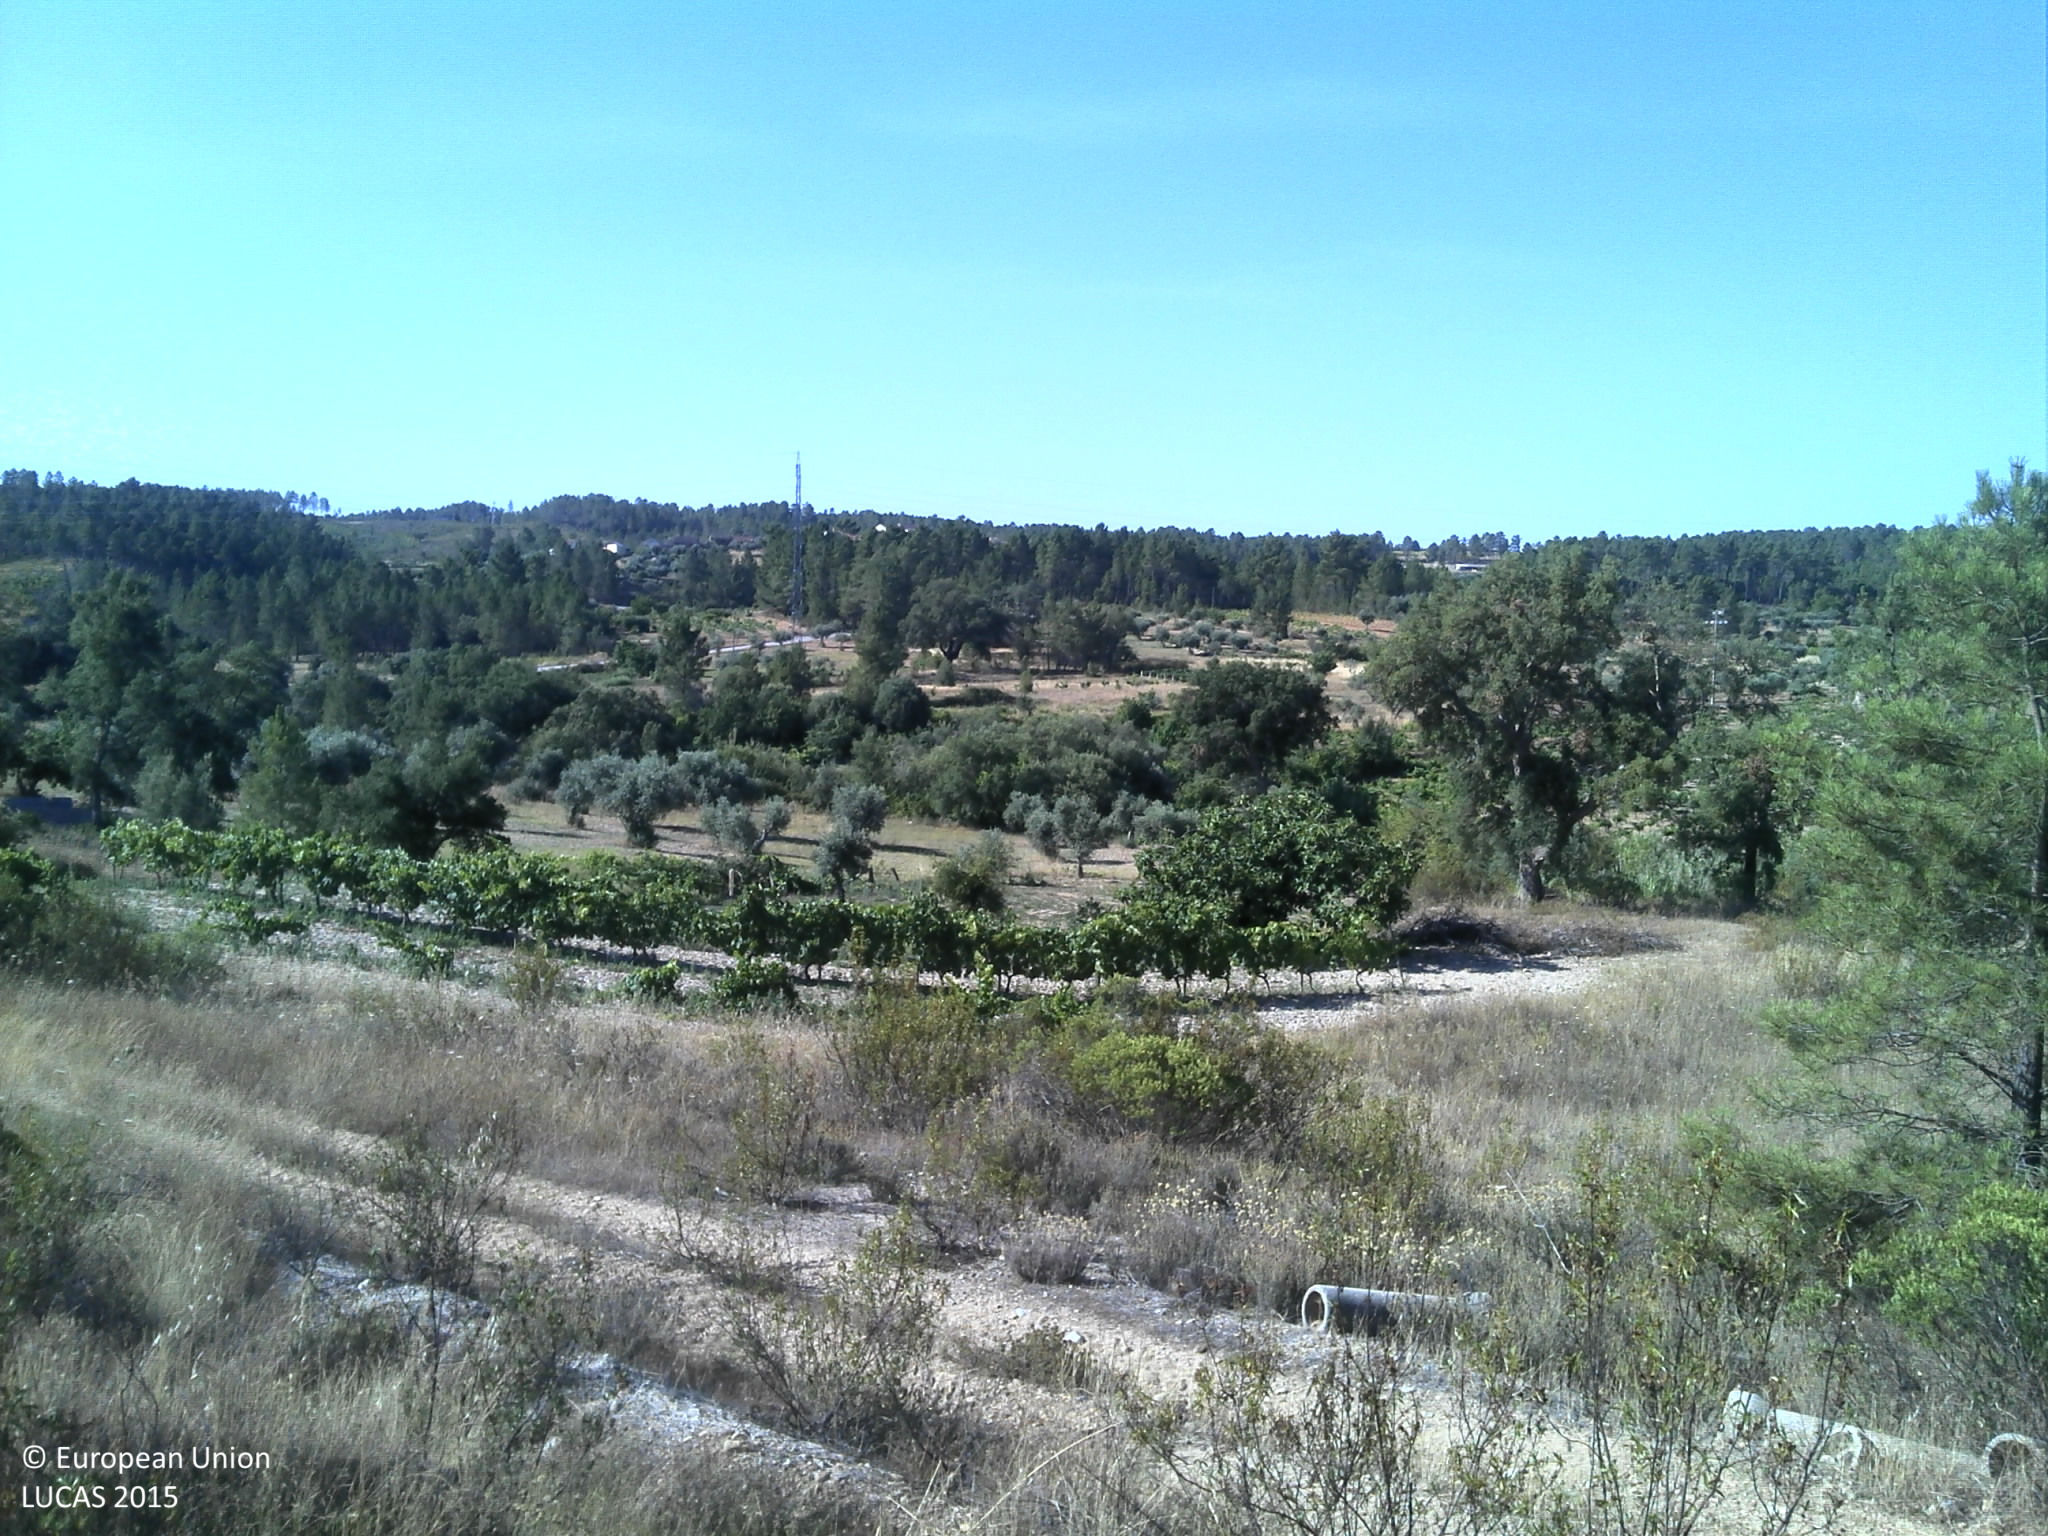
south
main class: Shrubland
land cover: Shrubland with sparse tree cover
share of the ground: 25 - 50 %
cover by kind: shrubs 45 %, unconsolidated bare surface 30 %, herbaceous plants 20 %, broadleaved forest trees 5 %
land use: Forestry
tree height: > 5 m
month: July
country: PT
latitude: 39.8360
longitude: -7.6427
